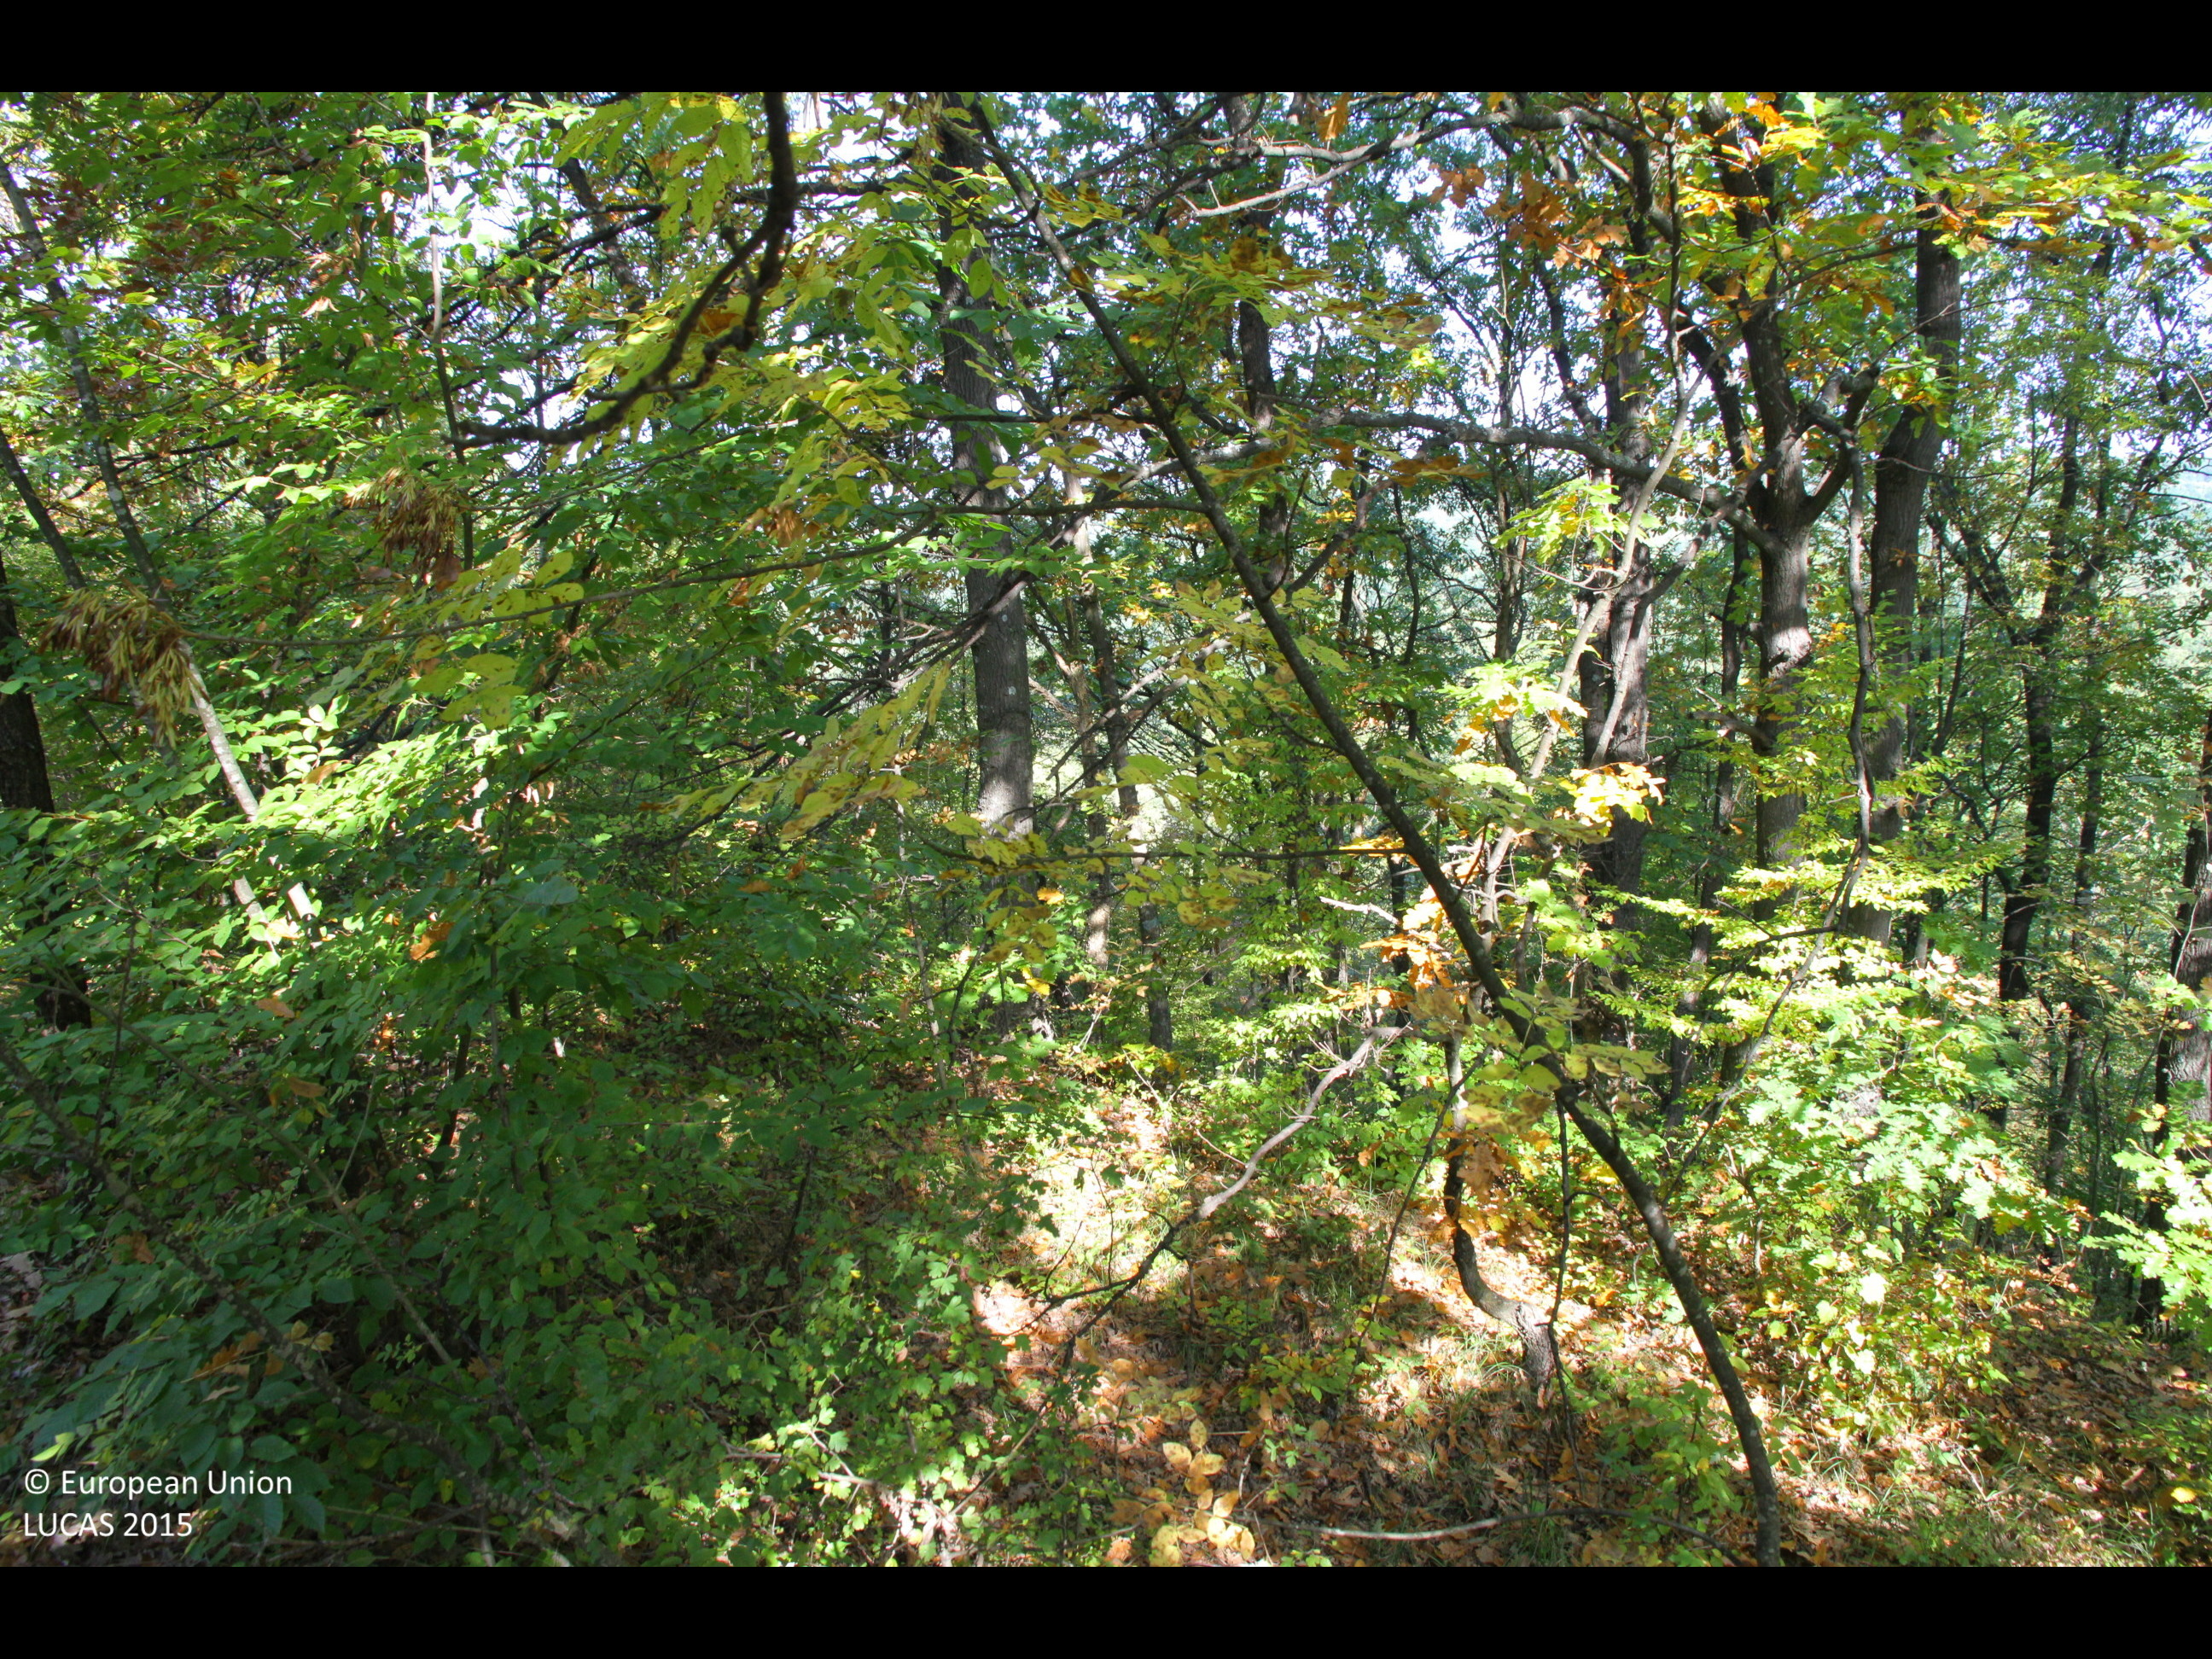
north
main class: Woodland
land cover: Broadleaved woodland
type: mesophytic deciduous forest
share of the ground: > 75 %
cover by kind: broadleaved forest trees 100 %
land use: Forestry
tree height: > 5 m
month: October
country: BG
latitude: 42.9986
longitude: 26.9517
